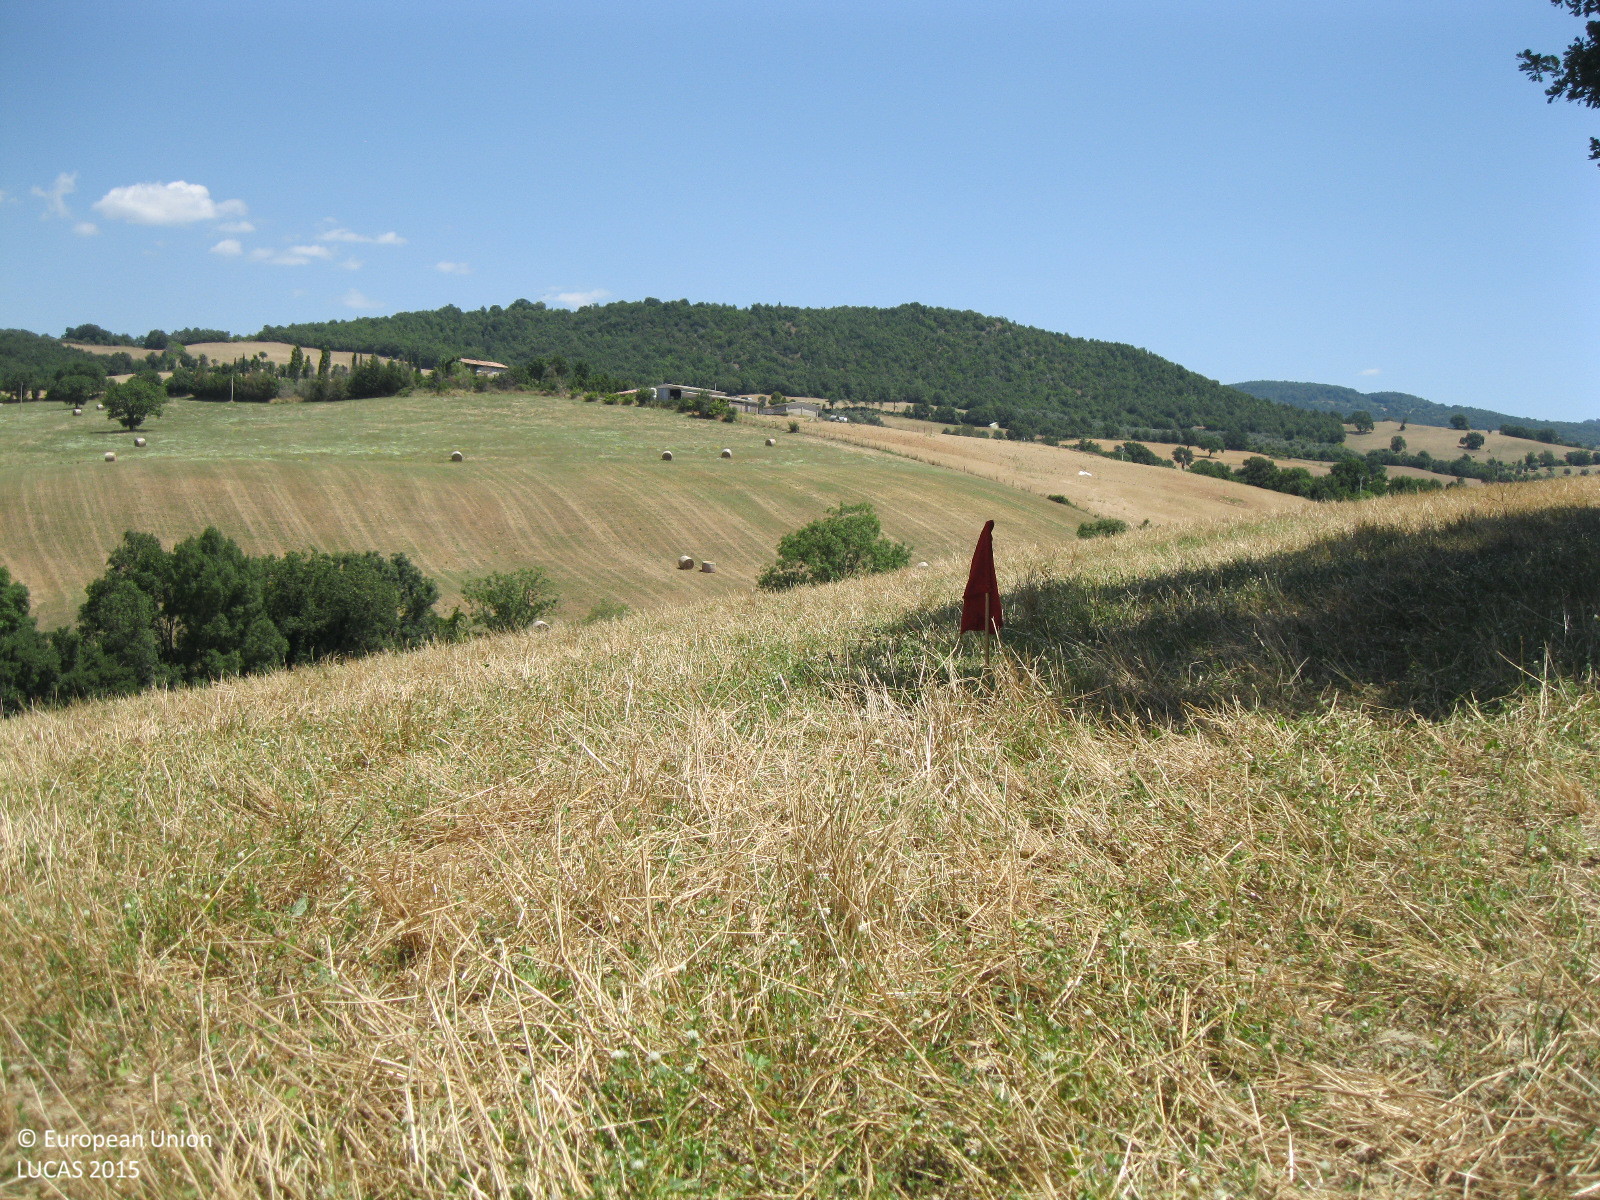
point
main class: Cropland
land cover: Temporary grasslands
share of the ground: > 75 %
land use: Agriculture (excluding fallow land and kitchen gardens)
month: July
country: IT
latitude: 42.6972
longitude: 11.4965
